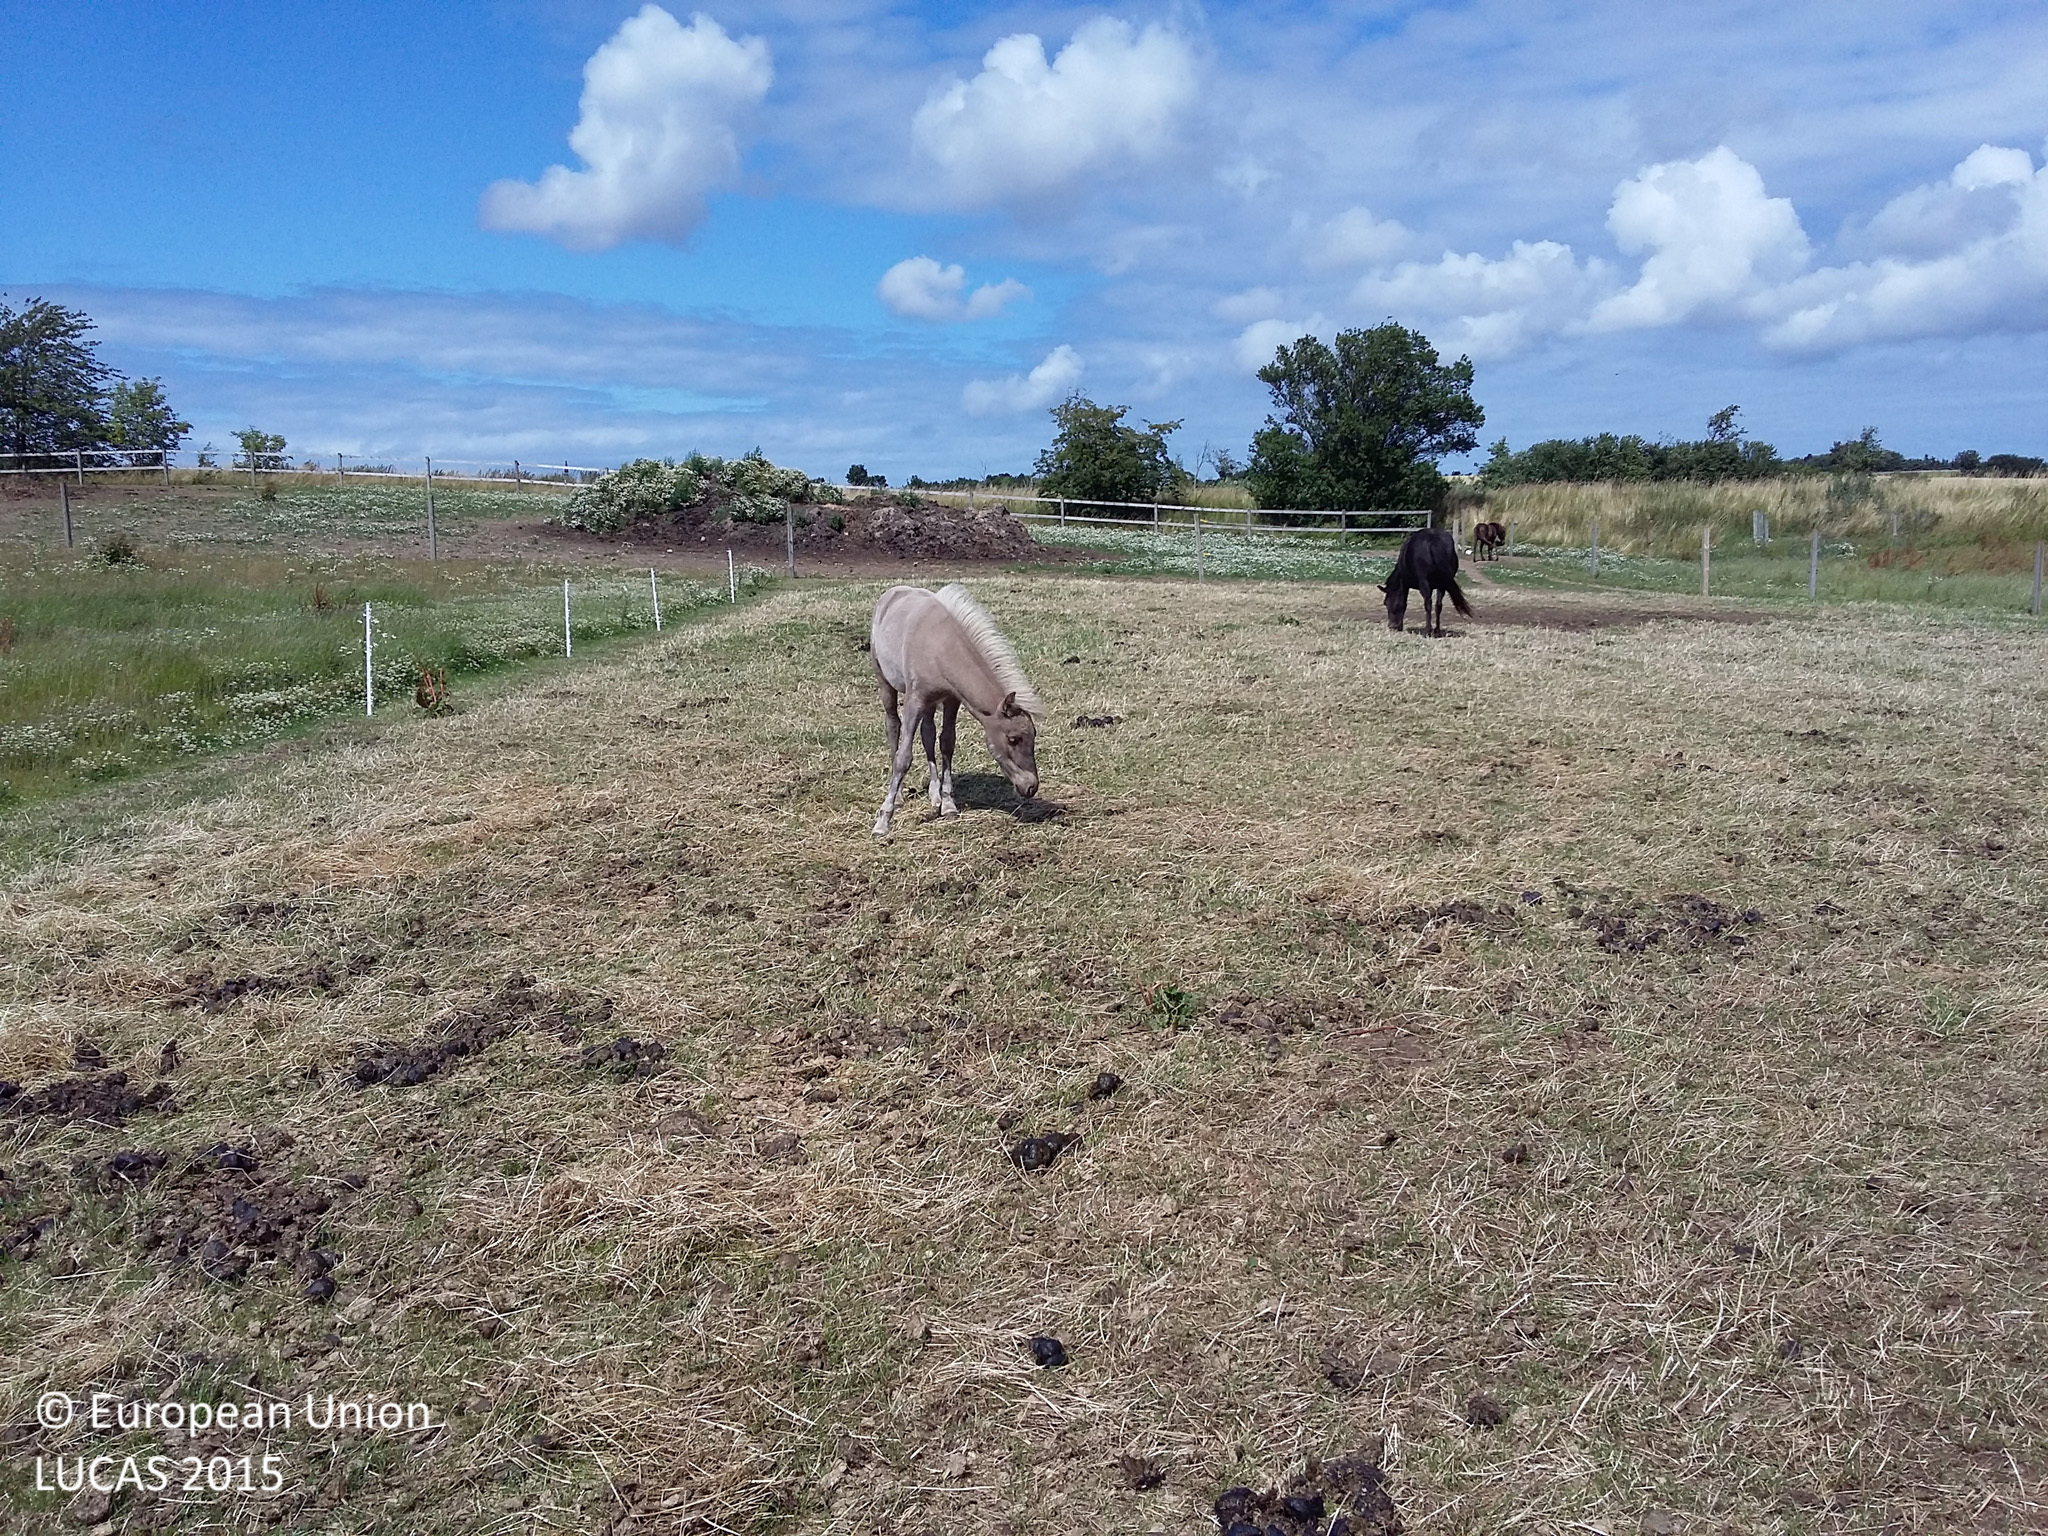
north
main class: Grassland
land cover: Grassland without tree/shrub cover
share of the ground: > 75 %
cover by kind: herbaceous plants 100 %
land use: Agriculture (excluding fallow land and kitchen gardens)
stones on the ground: < 10 %
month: July
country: DK
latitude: 56.0246
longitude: 12.2281
